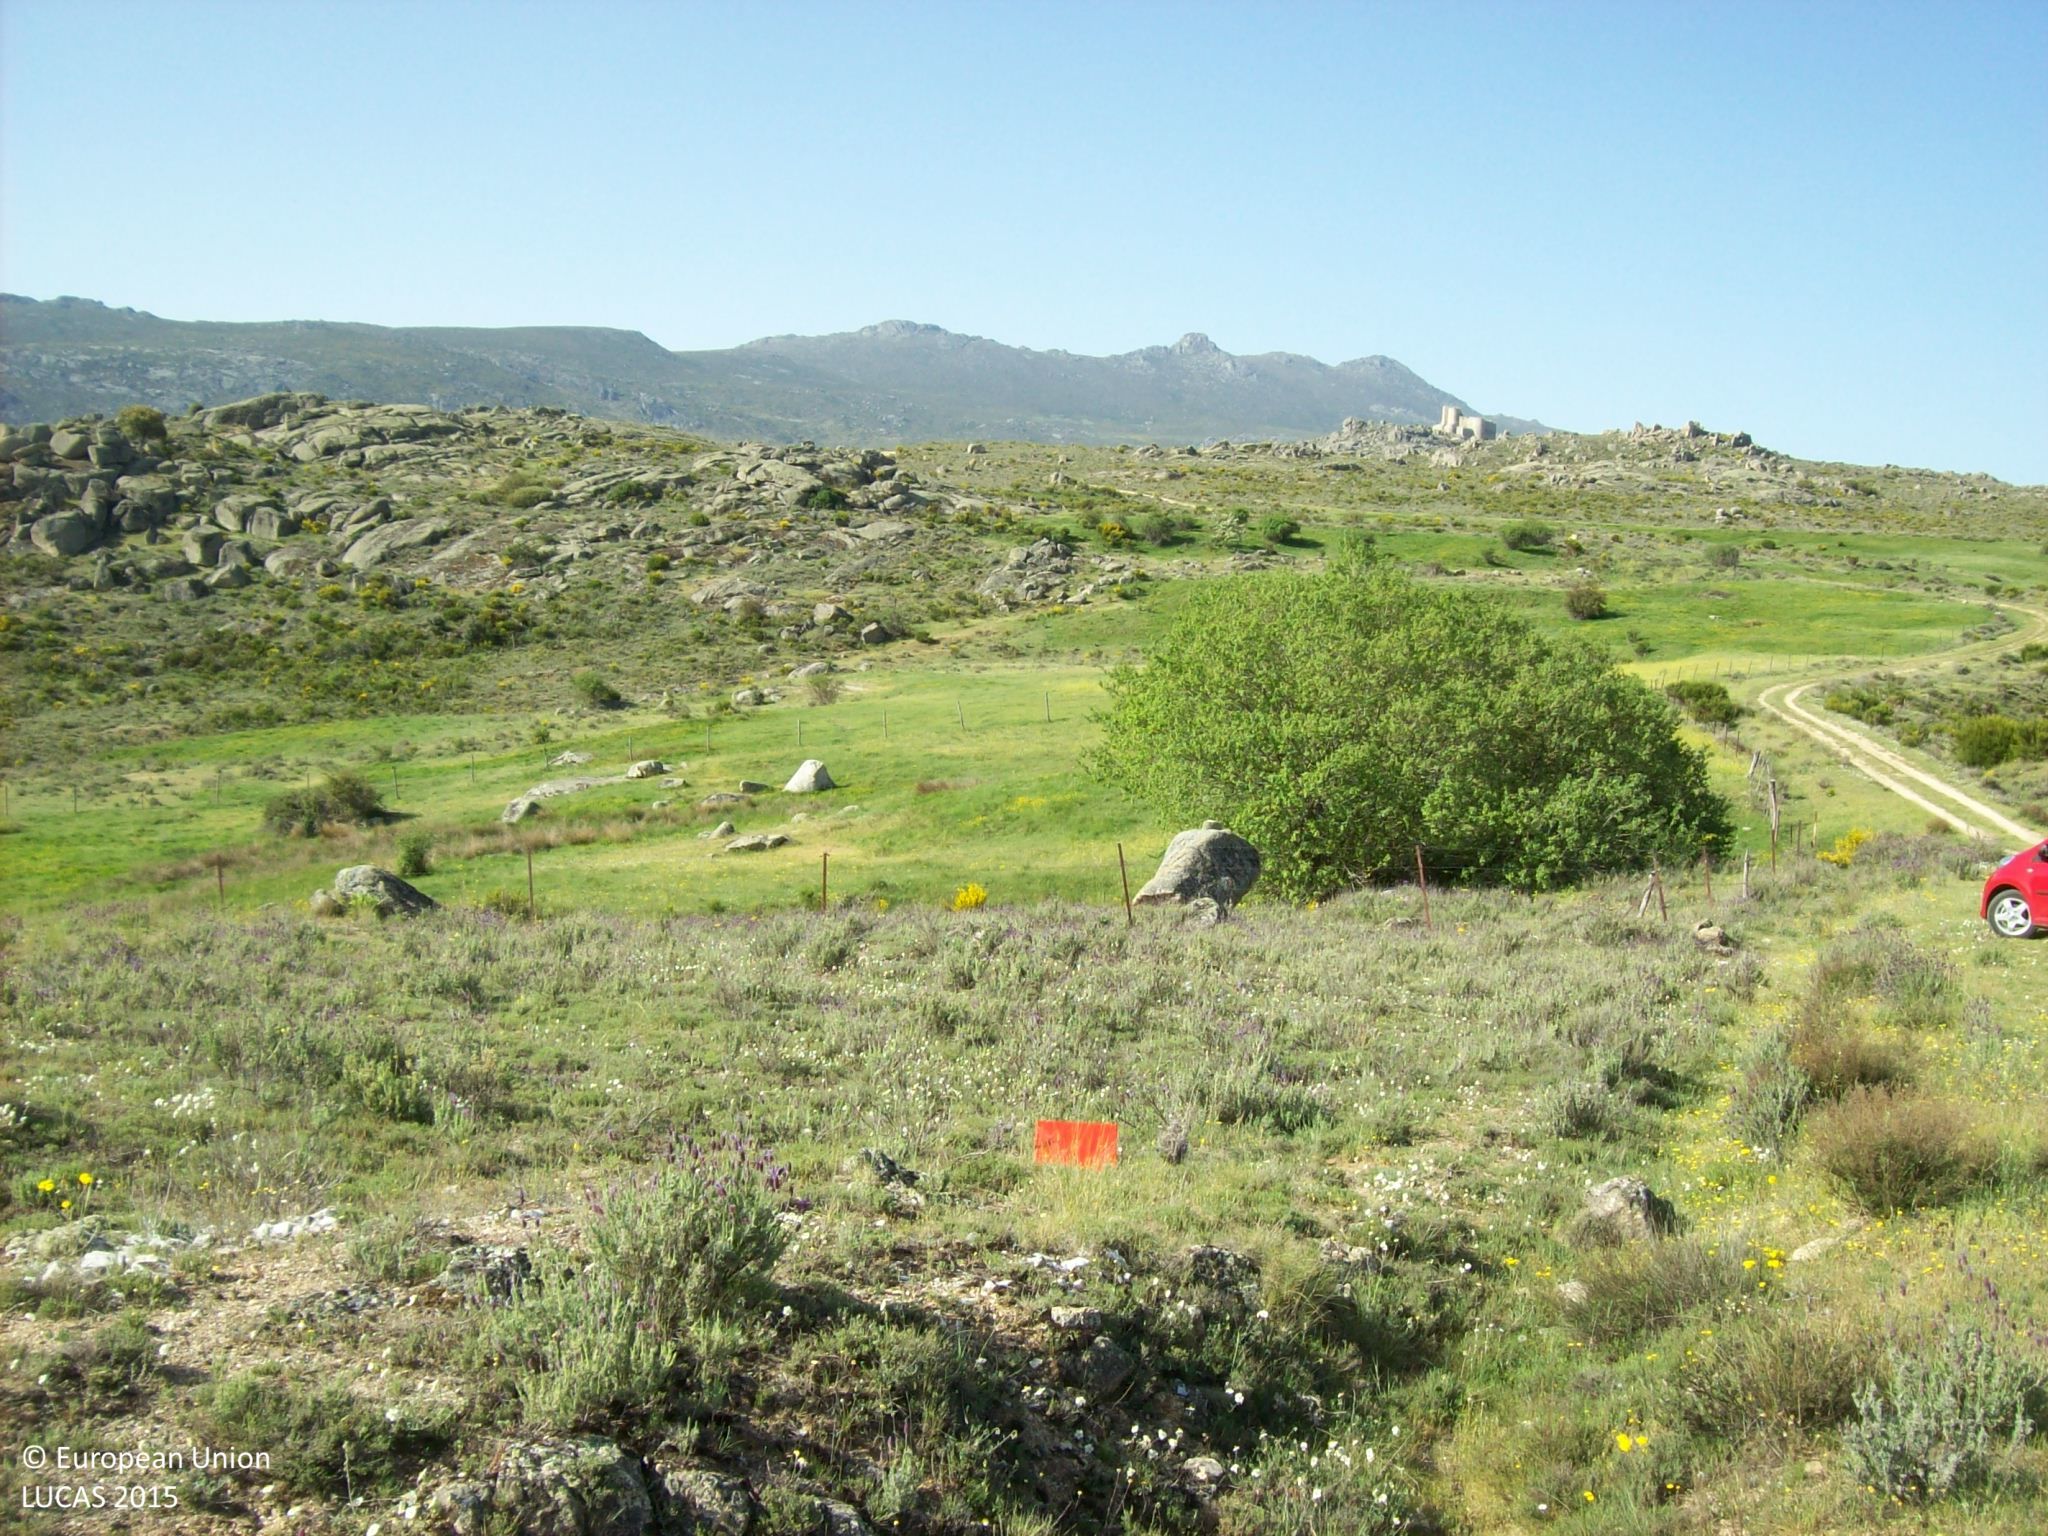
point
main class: Shrubland
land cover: Shrubland without tree cover
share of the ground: 50 - 75 %
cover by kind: shrubs 60 %, herbaceous plants 20 %, consolidated bare surface 5 %, unconsolidated bare surface 5 %
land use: Semi-natural and natural areas not in use
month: May
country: ES
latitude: 40.5470
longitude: -4.8280
